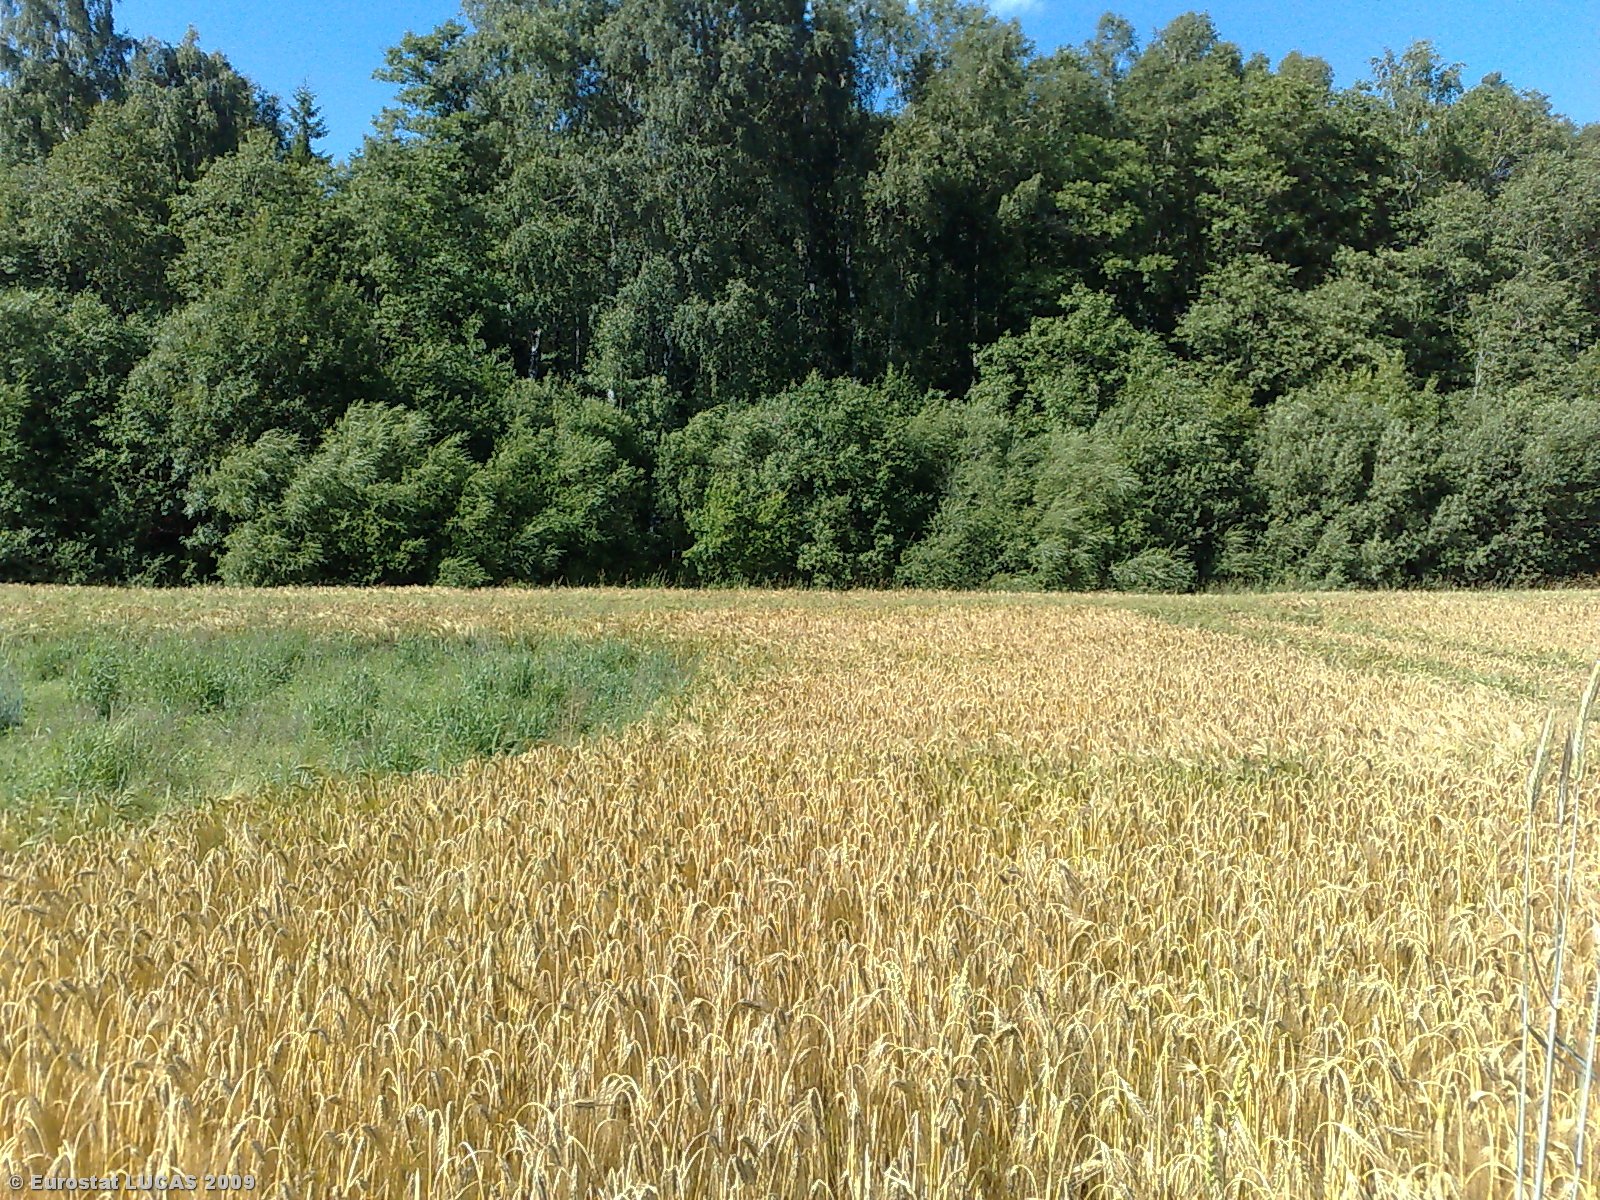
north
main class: Cropland
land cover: Triticale
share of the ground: > 75 %
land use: Agriculture (excluding fallow land and kitchen gardens)
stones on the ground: < 10 %
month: July
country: LT
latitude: 56.0942
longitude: 22.9416
